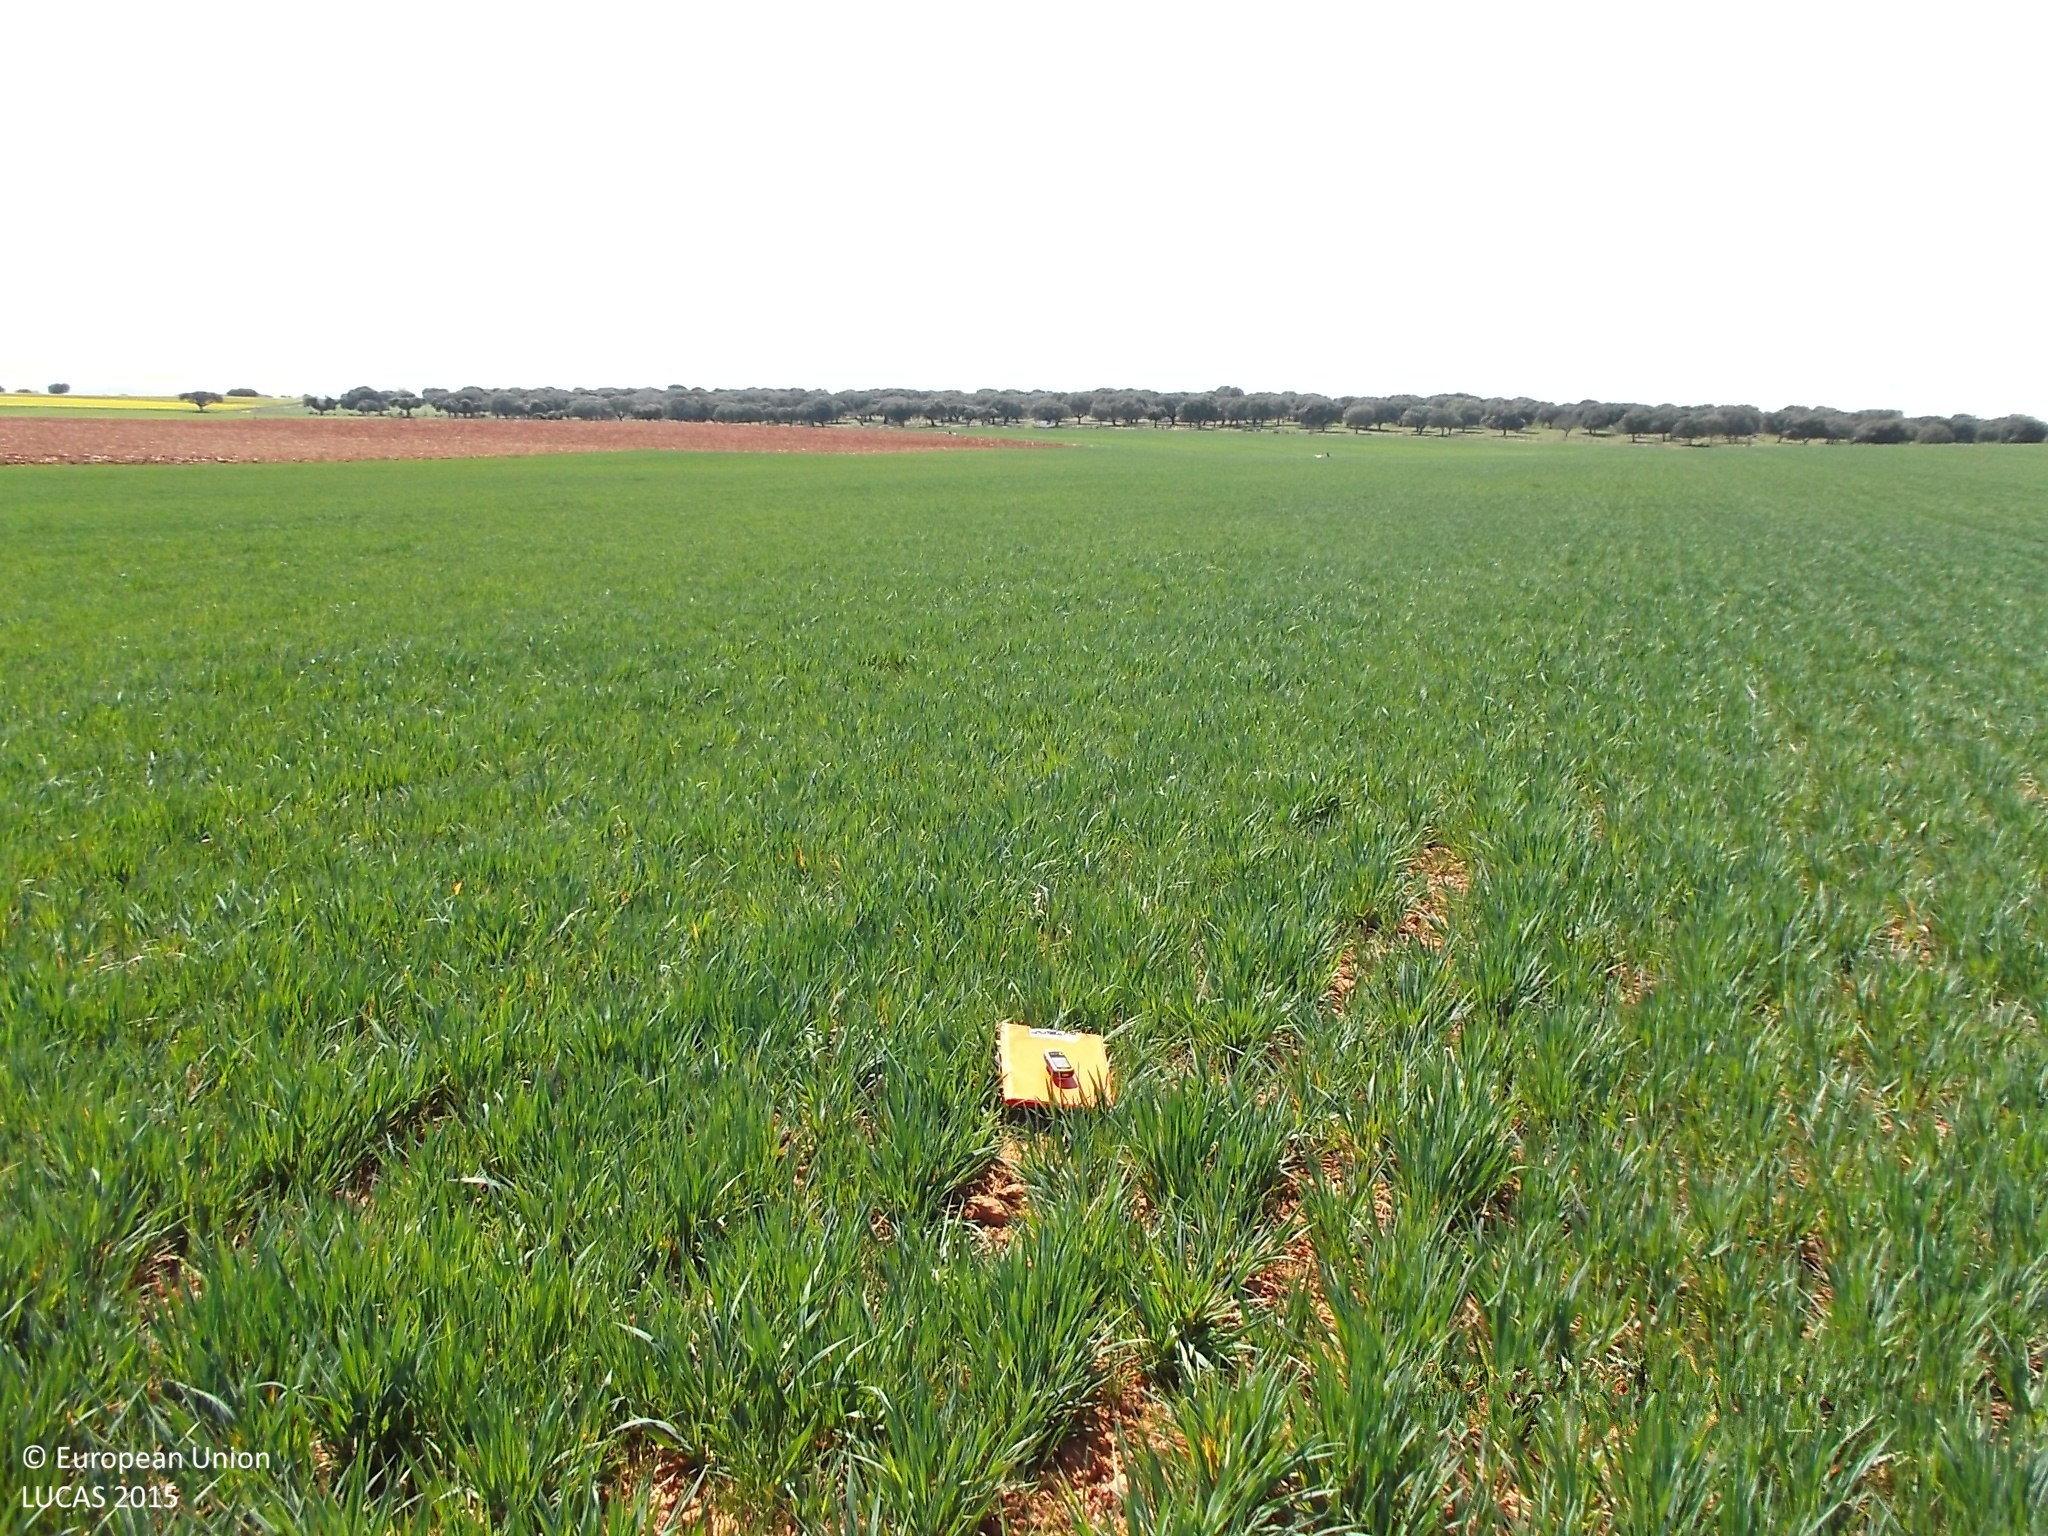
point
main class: Cropland
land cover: Oats
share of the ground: > 75 %
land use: Agriculture (excluding fallow land and kitchen gardens)
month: April
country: ES
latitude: 40.8669
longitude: -5.9444
